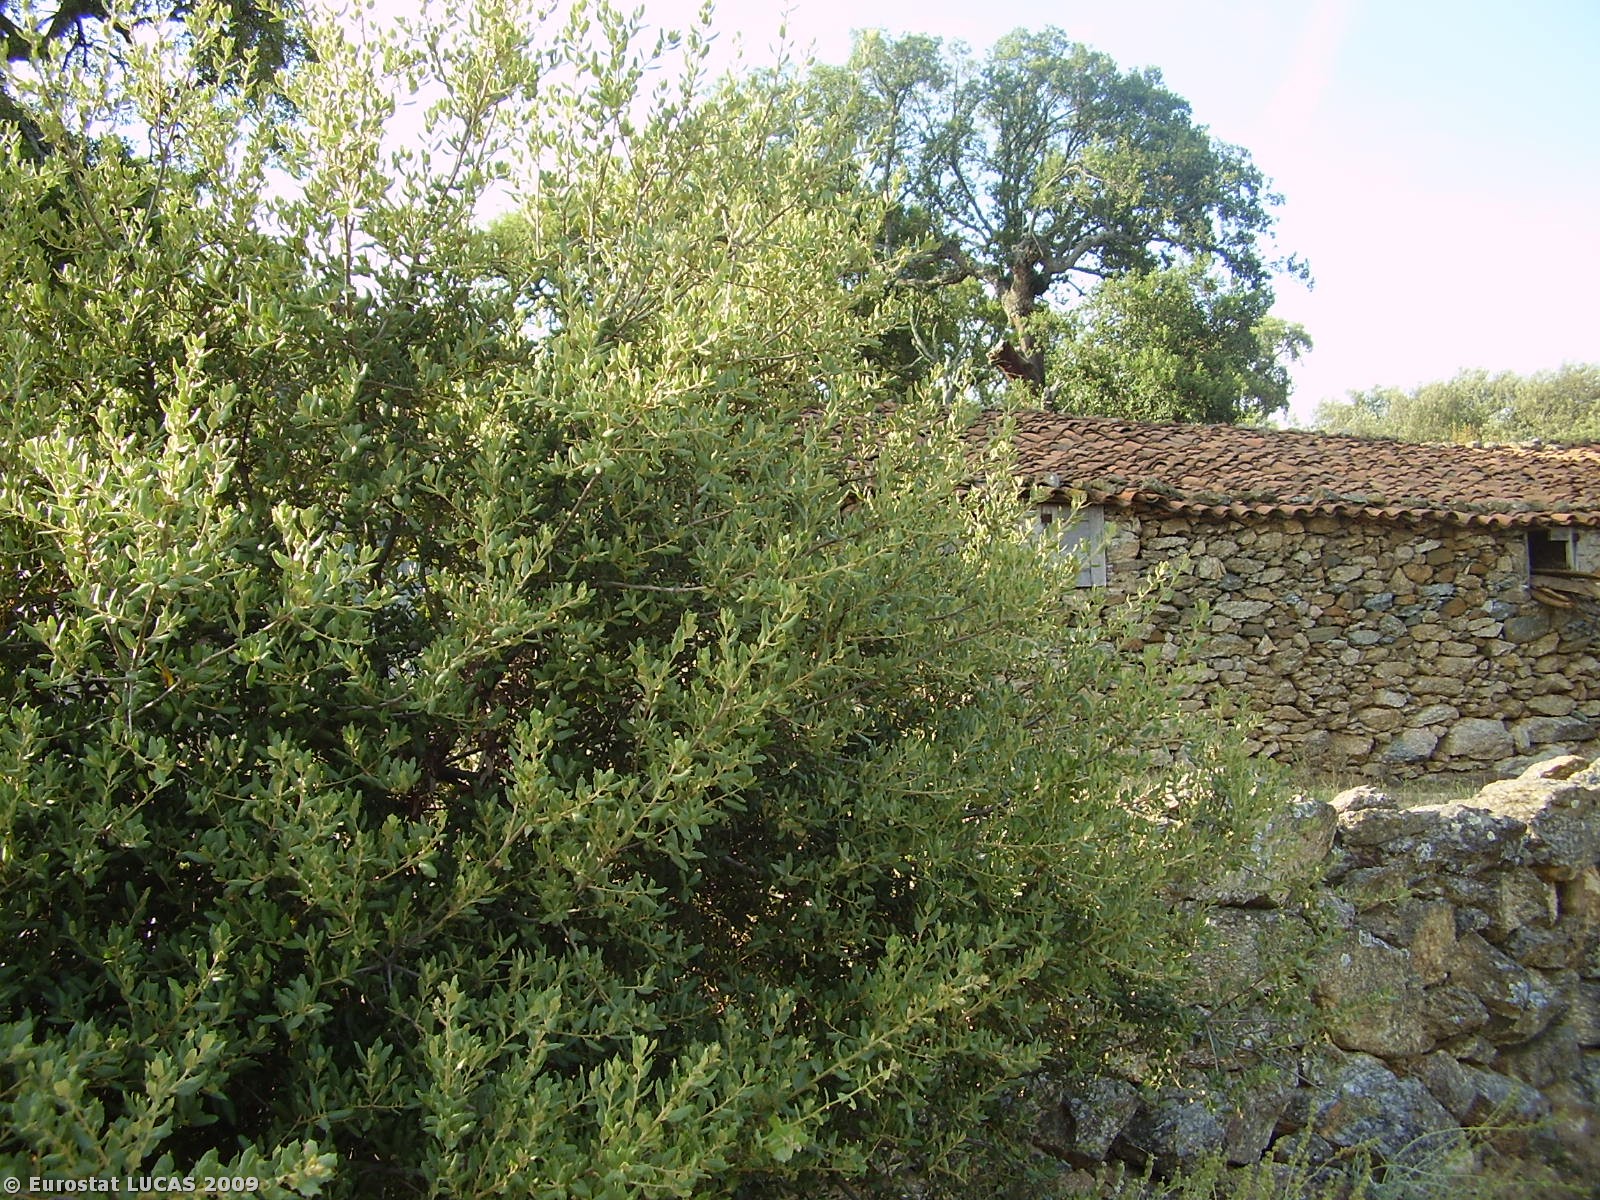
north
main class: Grassland
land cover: Grassland with sparse tree/shrub cover
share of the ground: 50 - 75 %
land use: Forestry
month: June
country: PT
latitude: 41.4797
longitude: -6.7914
